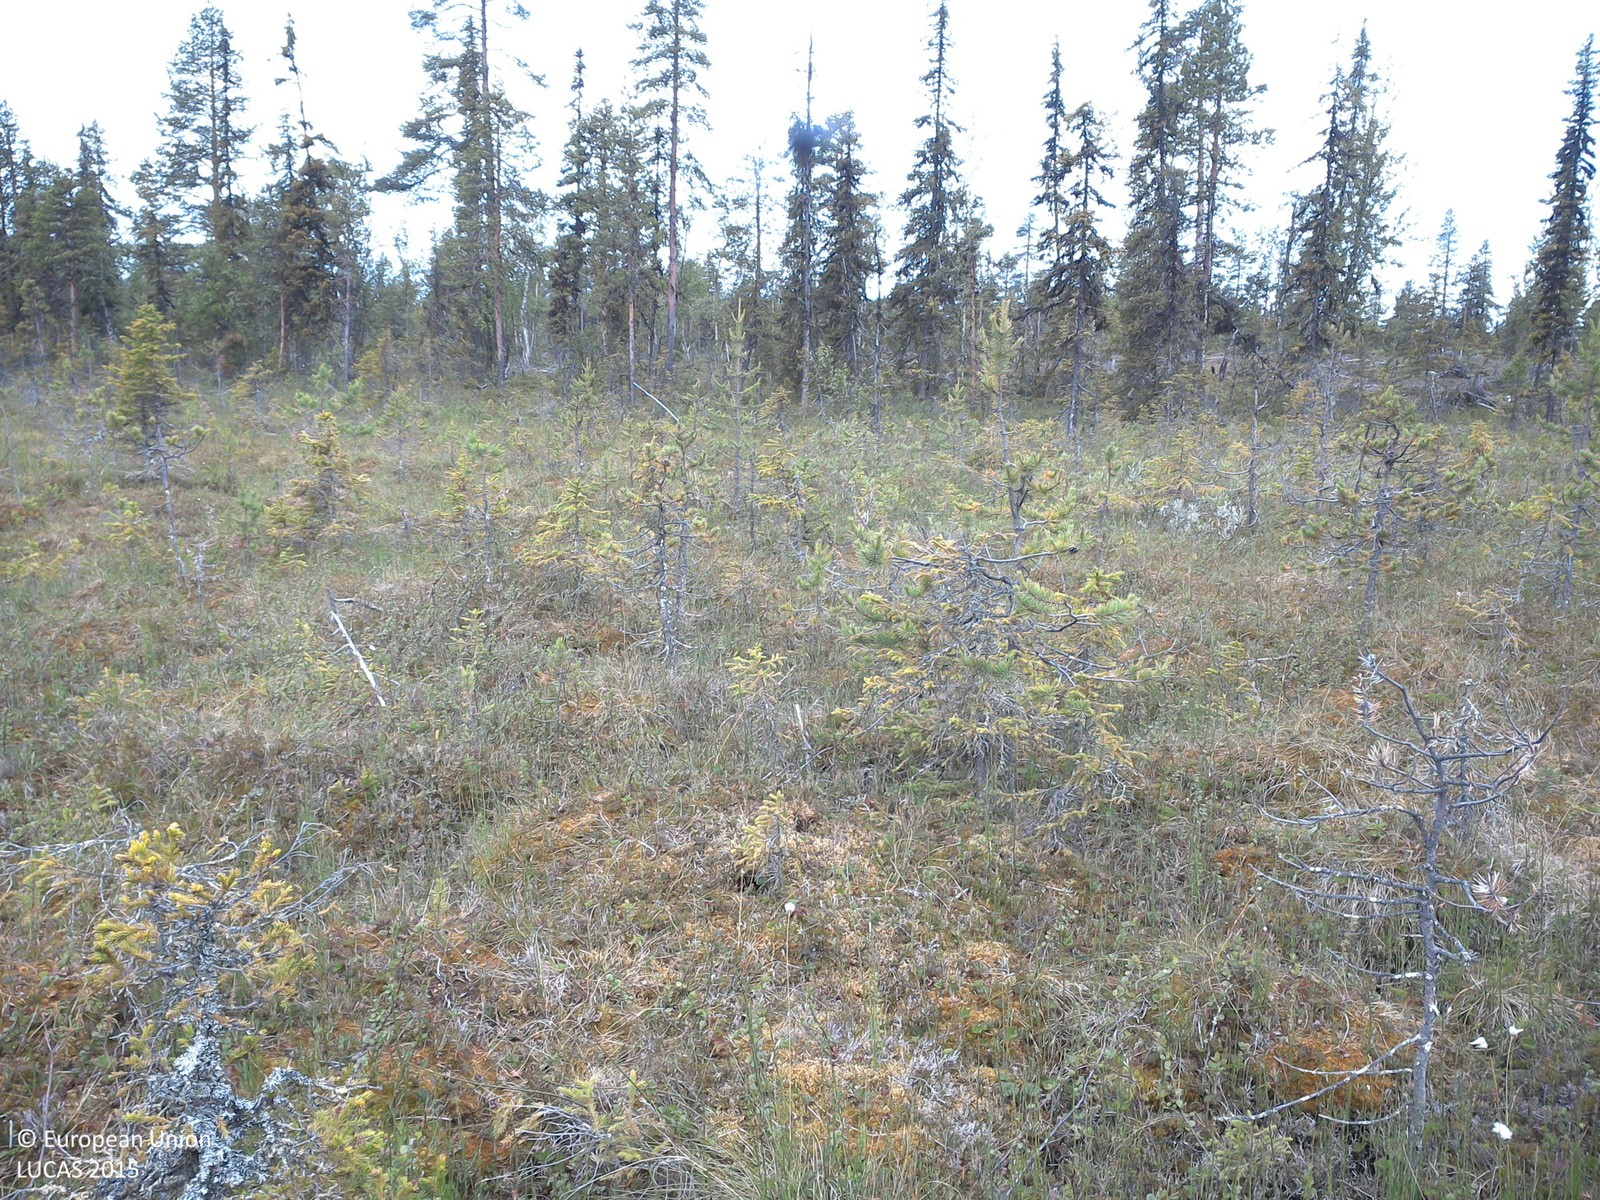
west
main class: Woodland
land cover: Spruce dominated coniferous woodland
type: boreal forest
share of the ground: 10 - 25 %
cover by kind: lichens and mosses 45 %, shrubs 25 %, herbaceous plants 20 %, coniferous forest trees 10 %
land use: Forestry
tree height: < 5 m
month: July
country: SE
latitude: 67.6897
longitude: 21.0624
